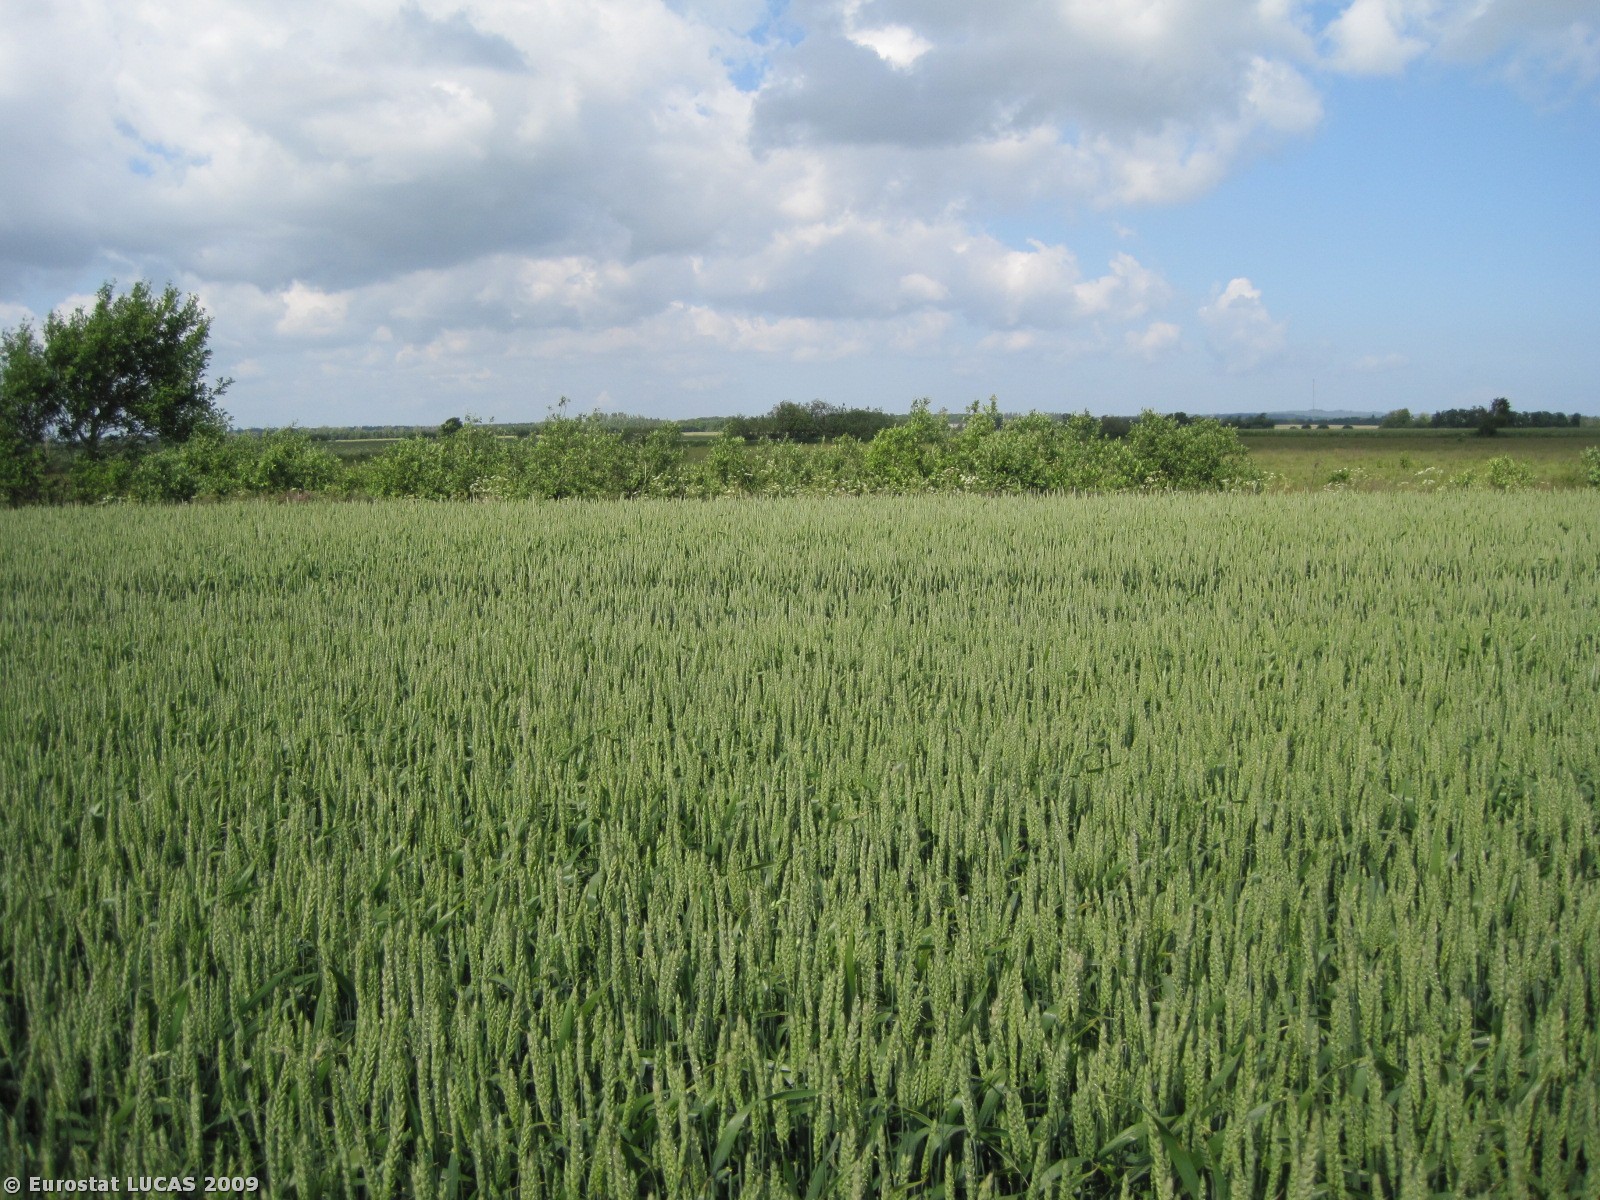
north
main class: Cropland
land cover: Common wheat
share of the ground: > 75 %
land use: Agriculture (excluding fallow land and kitchen gardens)
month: June
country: DK
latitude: 57.1224
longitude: 10.1814
